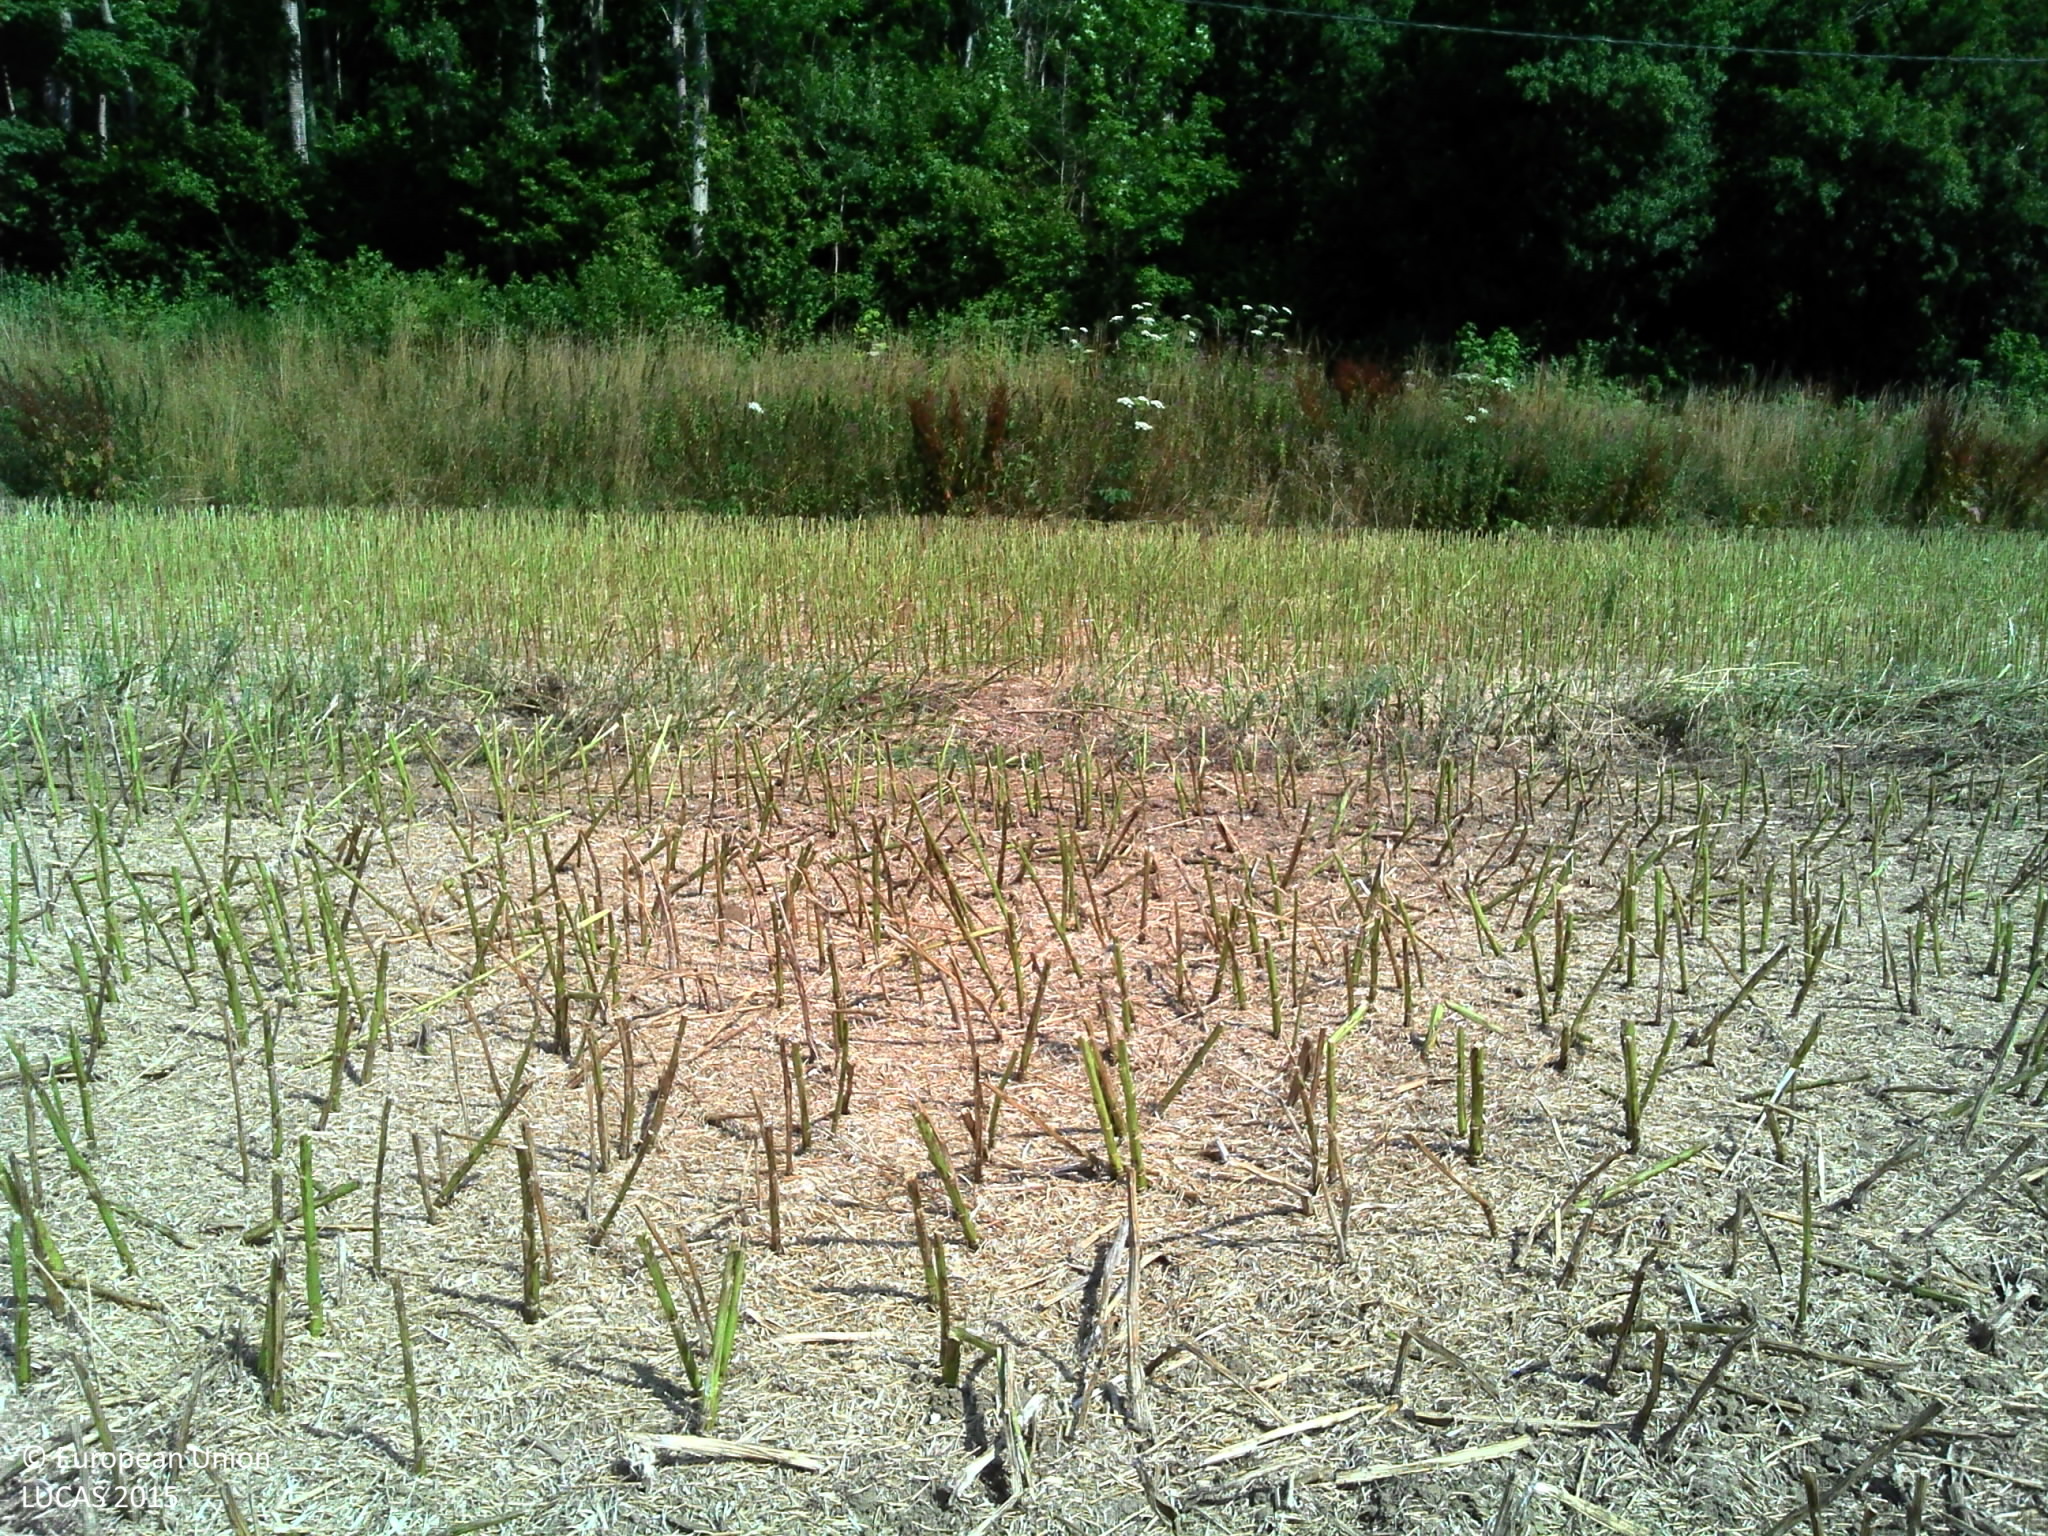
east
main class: Cropland
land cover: Rape and turnip rape
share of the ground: 25 - 50 %
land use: Agriculture (excluding fallow land and kitchen gardens)
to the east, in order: Rape and turnip rape; Grass margins; Electric lines; Tracks; Grass margins; Shruby margins; Broadleaved woodland; Tracks; Broadleaved woodland
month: August
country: FR
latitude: 50.7723
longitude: 2.0293
